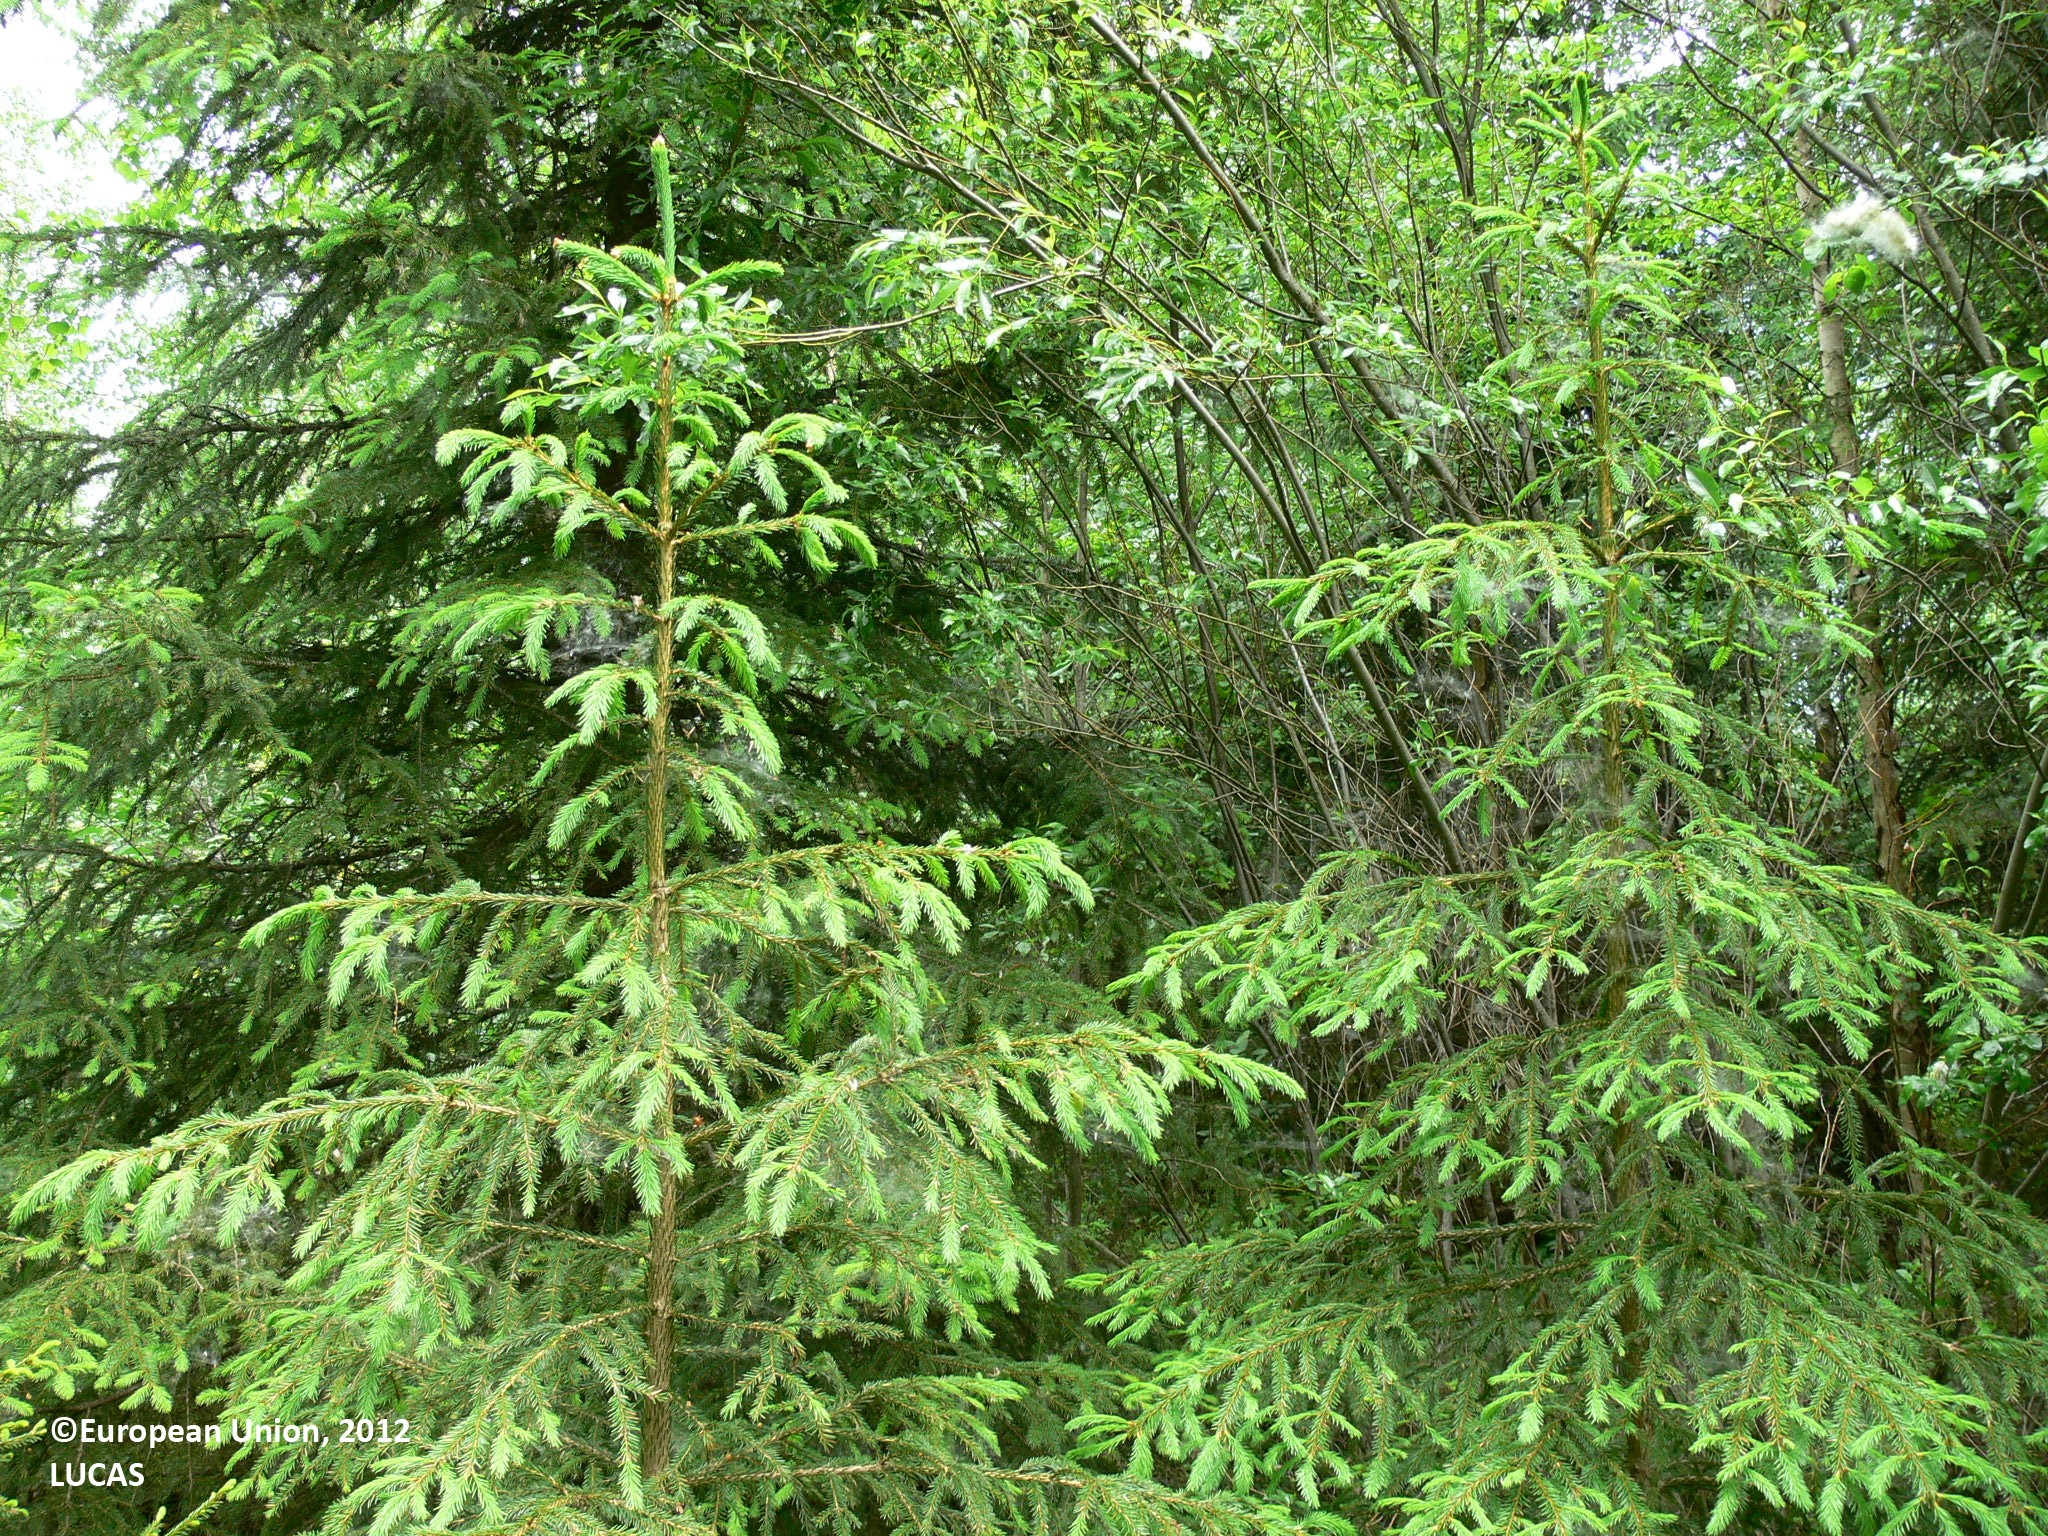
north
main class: Woodland
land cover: Spruce dominated mixed woodland
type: boreal forest
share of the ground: 50 - 75 %
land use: Forestry
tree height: > 5 m
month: June
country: FI
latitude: 62.7815
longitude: 29.8684
